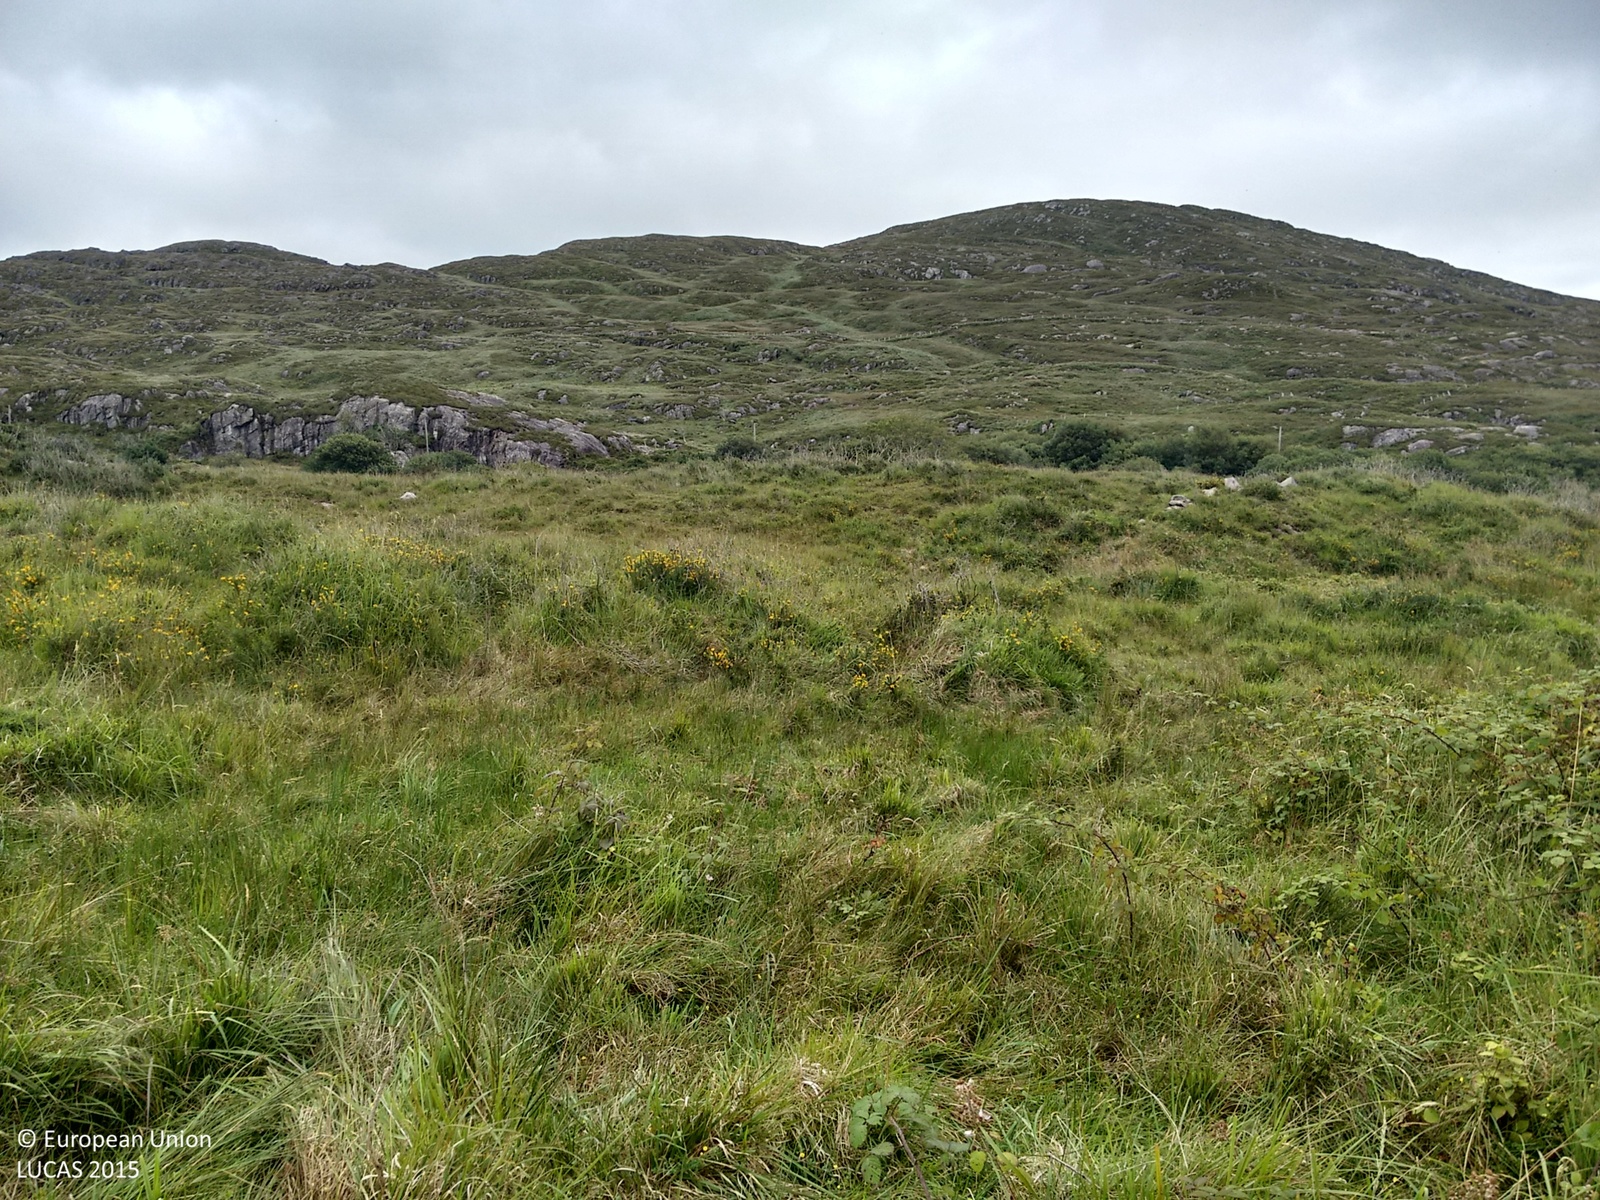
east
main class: Grassland
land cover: Grassland with sparse tree/shrub cover
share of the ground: > 75 %
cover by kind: herbaceous plants 85 %, shrubs 10 %, broadleaved forest trees 5 %
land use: Agriculture (excluding fallow land and kitchen gardens)
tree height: < 5 m
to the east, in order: Grassland with sparse tree/shrub cover; Rivers and streams; Abandoned hedges; Grassland without tree/shrub cover; Fences; Electric lines; Paved roads, cycling and walking lanes; Rock outcrops; Grassland with sparse tree/shrub cover; Rock outcrops; Rivers and streams; Grassland with sparse tree/shrub cover
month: August
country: IE
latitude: 51.7963
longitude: -10.0181
